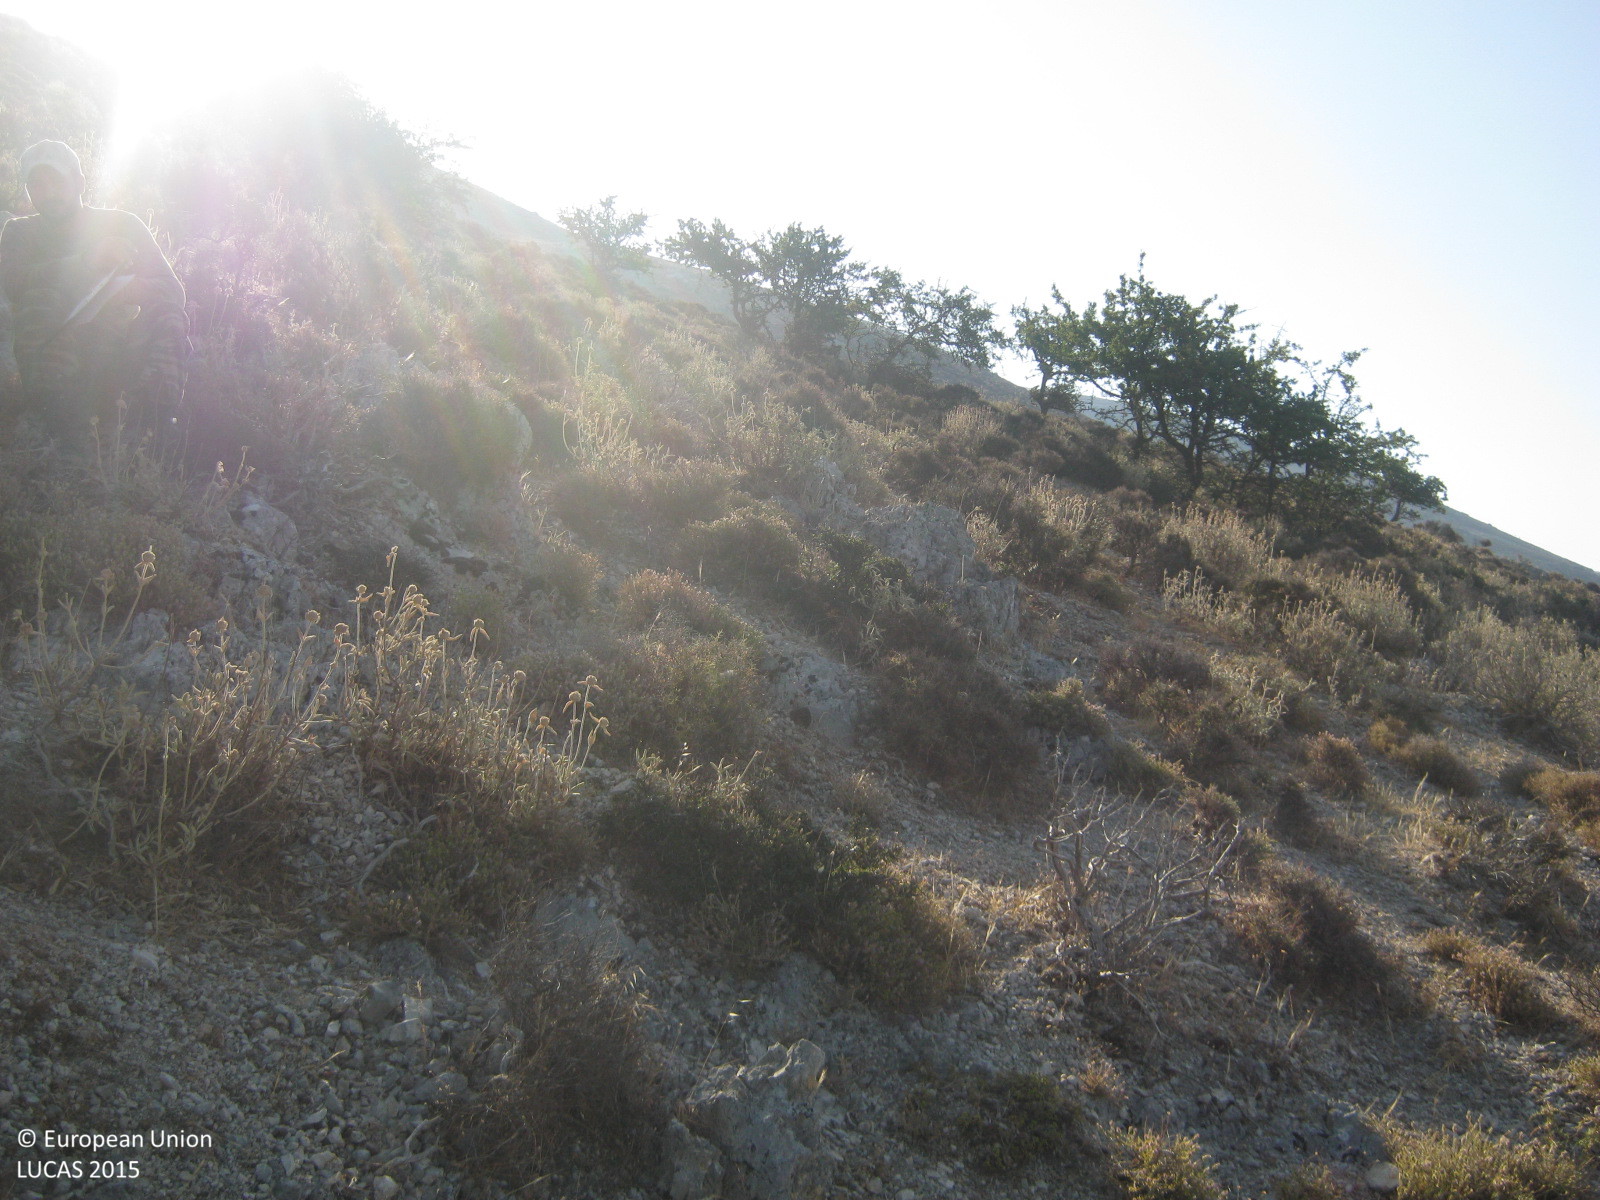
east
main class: Shrubland
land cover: Shrubland without tree cover
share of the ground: > 75 %
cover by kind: shrubs 70 %, unconsolidated bare surface 20 %, herbaceous plants 10 %
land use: Agriculture (excluding fallow land and kitchen gardens)
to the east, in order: Shrubland without tree cover; Rivers and streams; Shrubland without tree cover
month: August
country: GR
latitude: 38.2417
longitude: 20.5074
